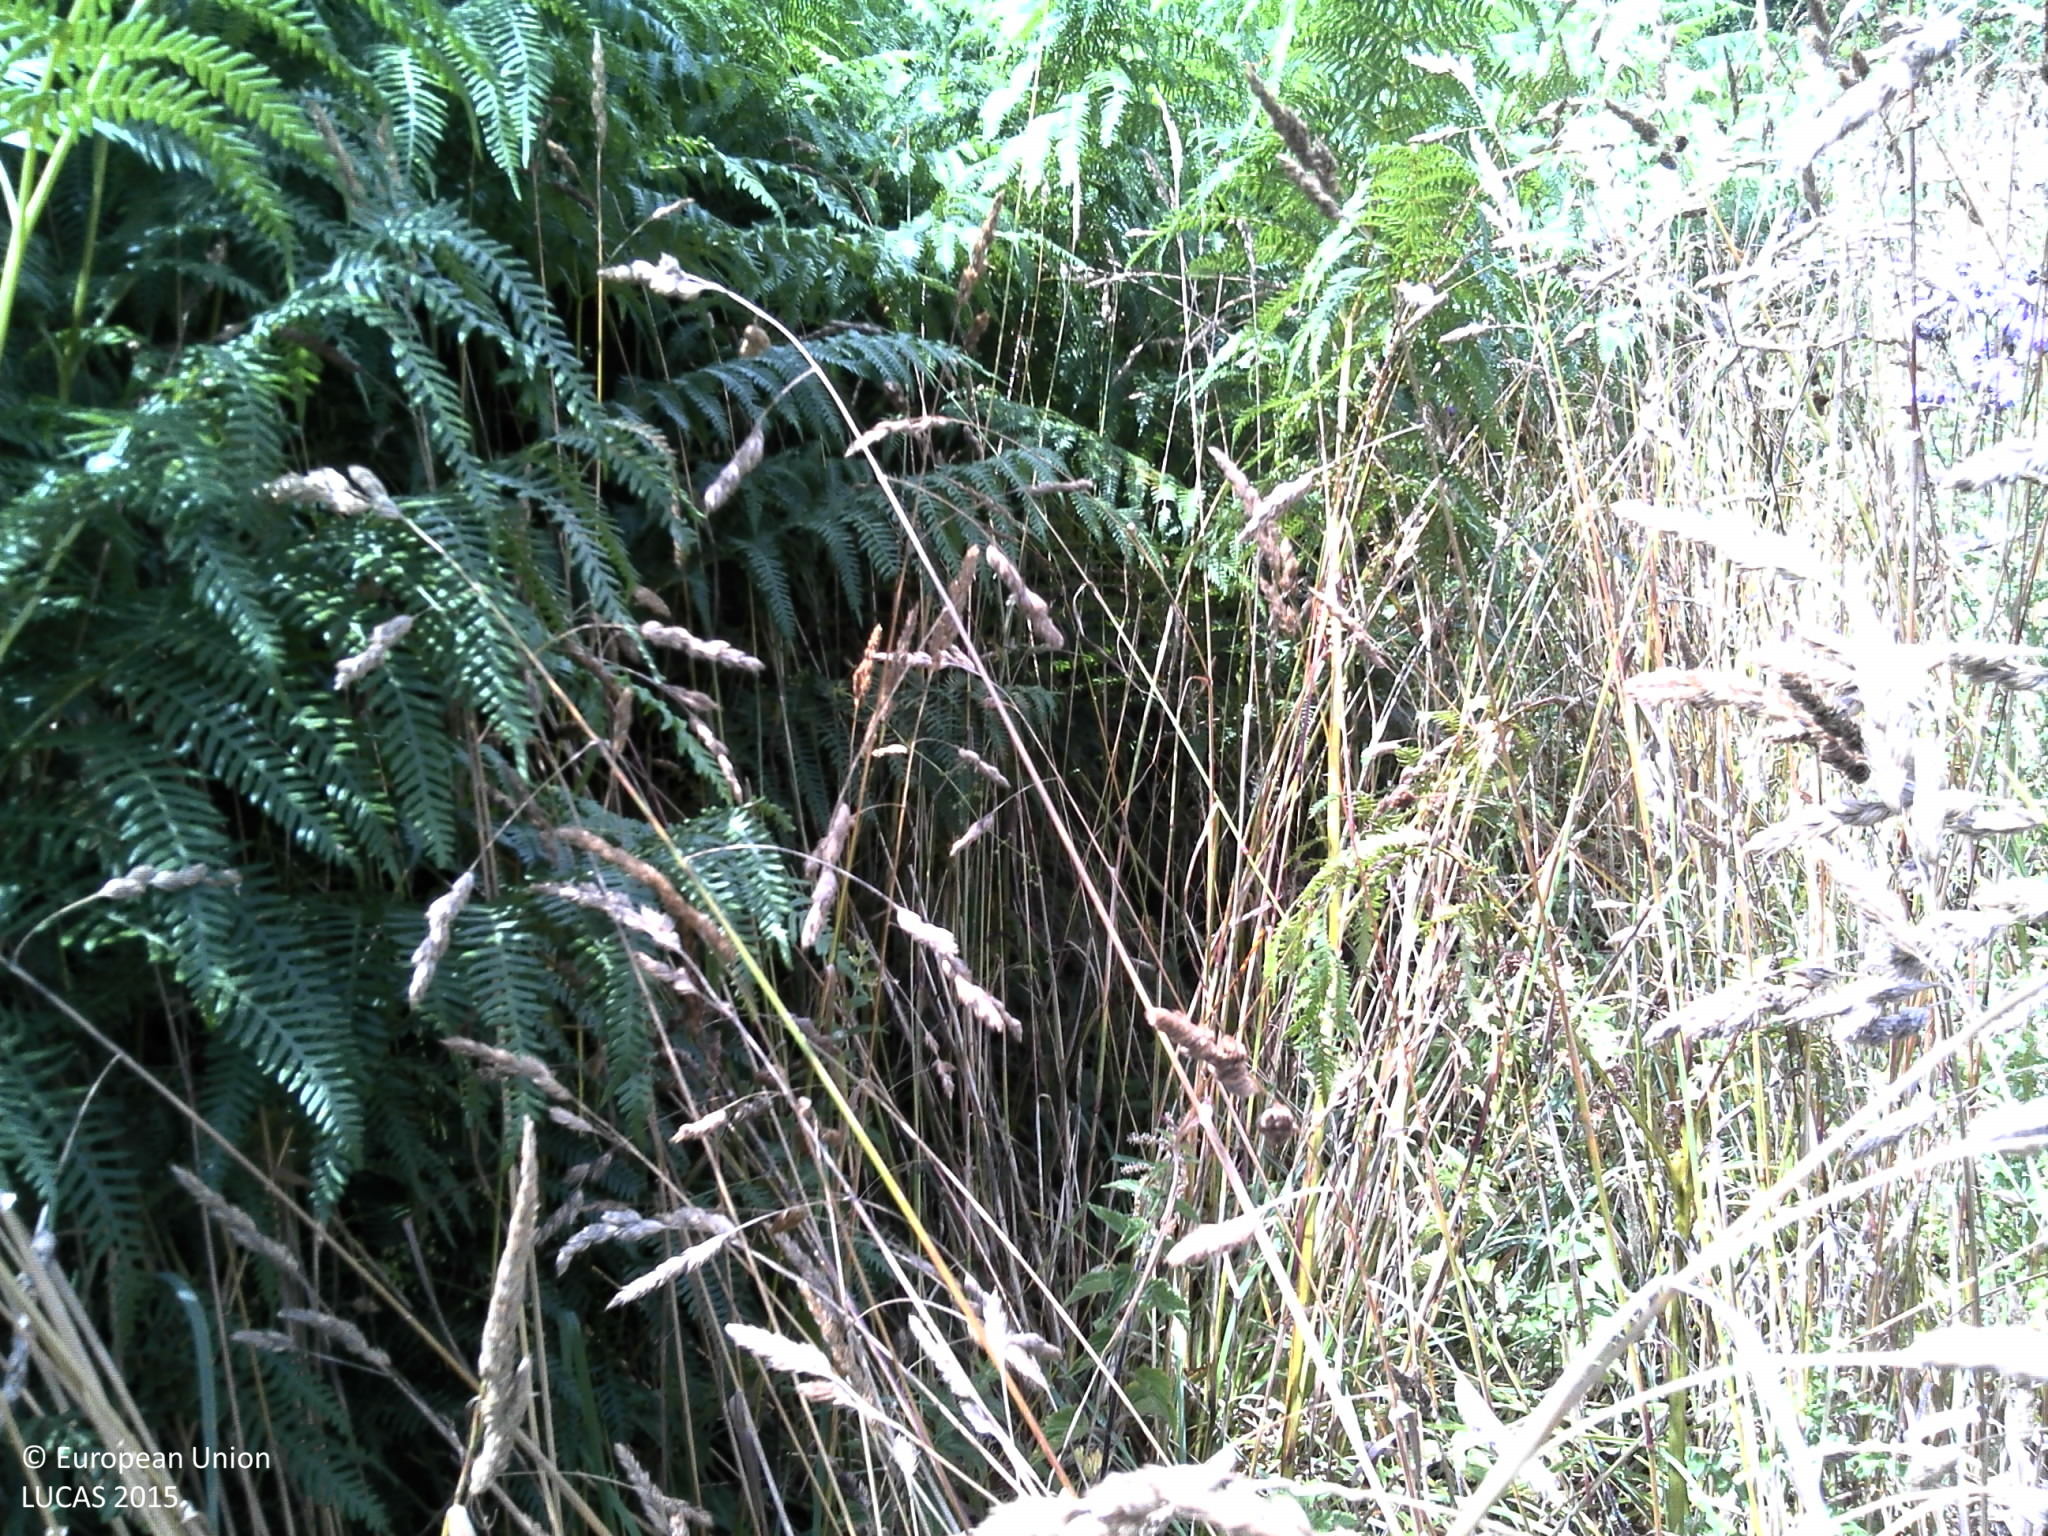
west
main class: Shrubland
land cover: Shrubland with sparse tree cover
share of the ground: > 75 %
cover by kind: shrubs 70 %, herbaceous plants 25 %, broadleaved forest trees 5 %
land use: Semi-natural and natural areas not in use
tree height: > 5 m
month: July
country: FR
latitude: 48.0590
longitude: -4.1104
